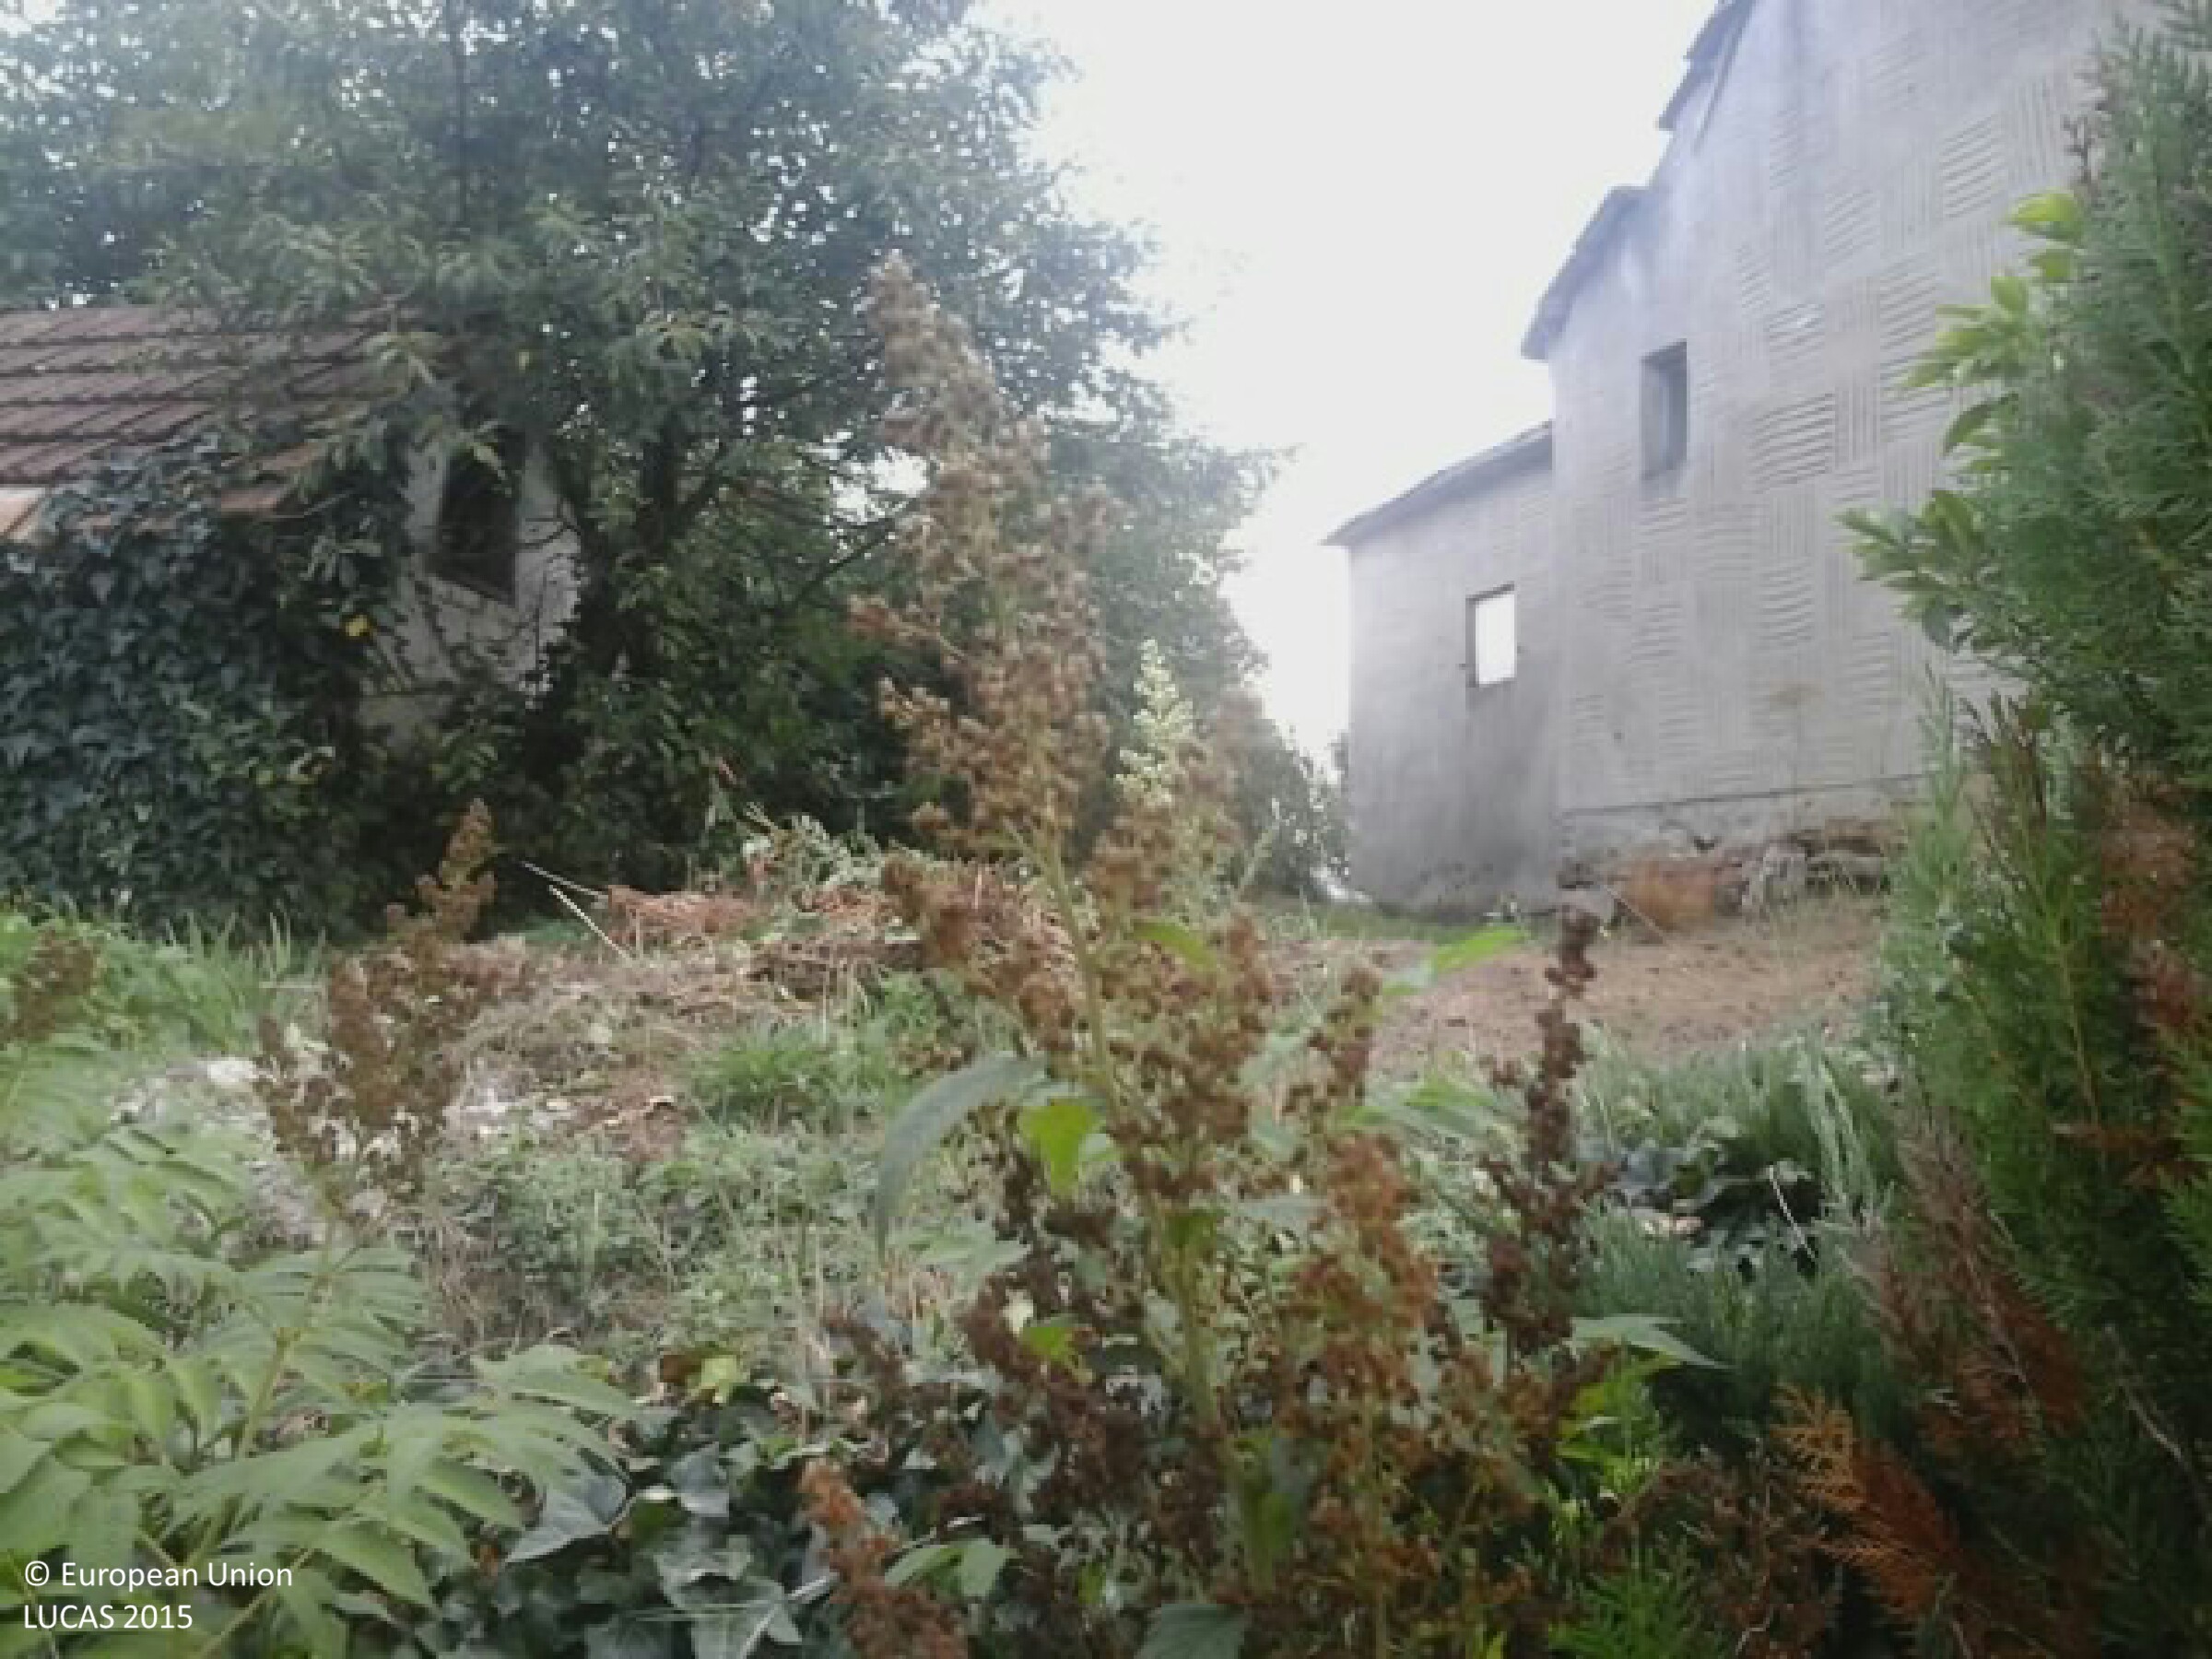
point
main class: Cropland
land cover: Floriculture and ornamental plants
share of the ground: > 75 %
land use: Kitchen garden
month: August
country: HU
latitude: 46.2359
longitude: 18.1901
